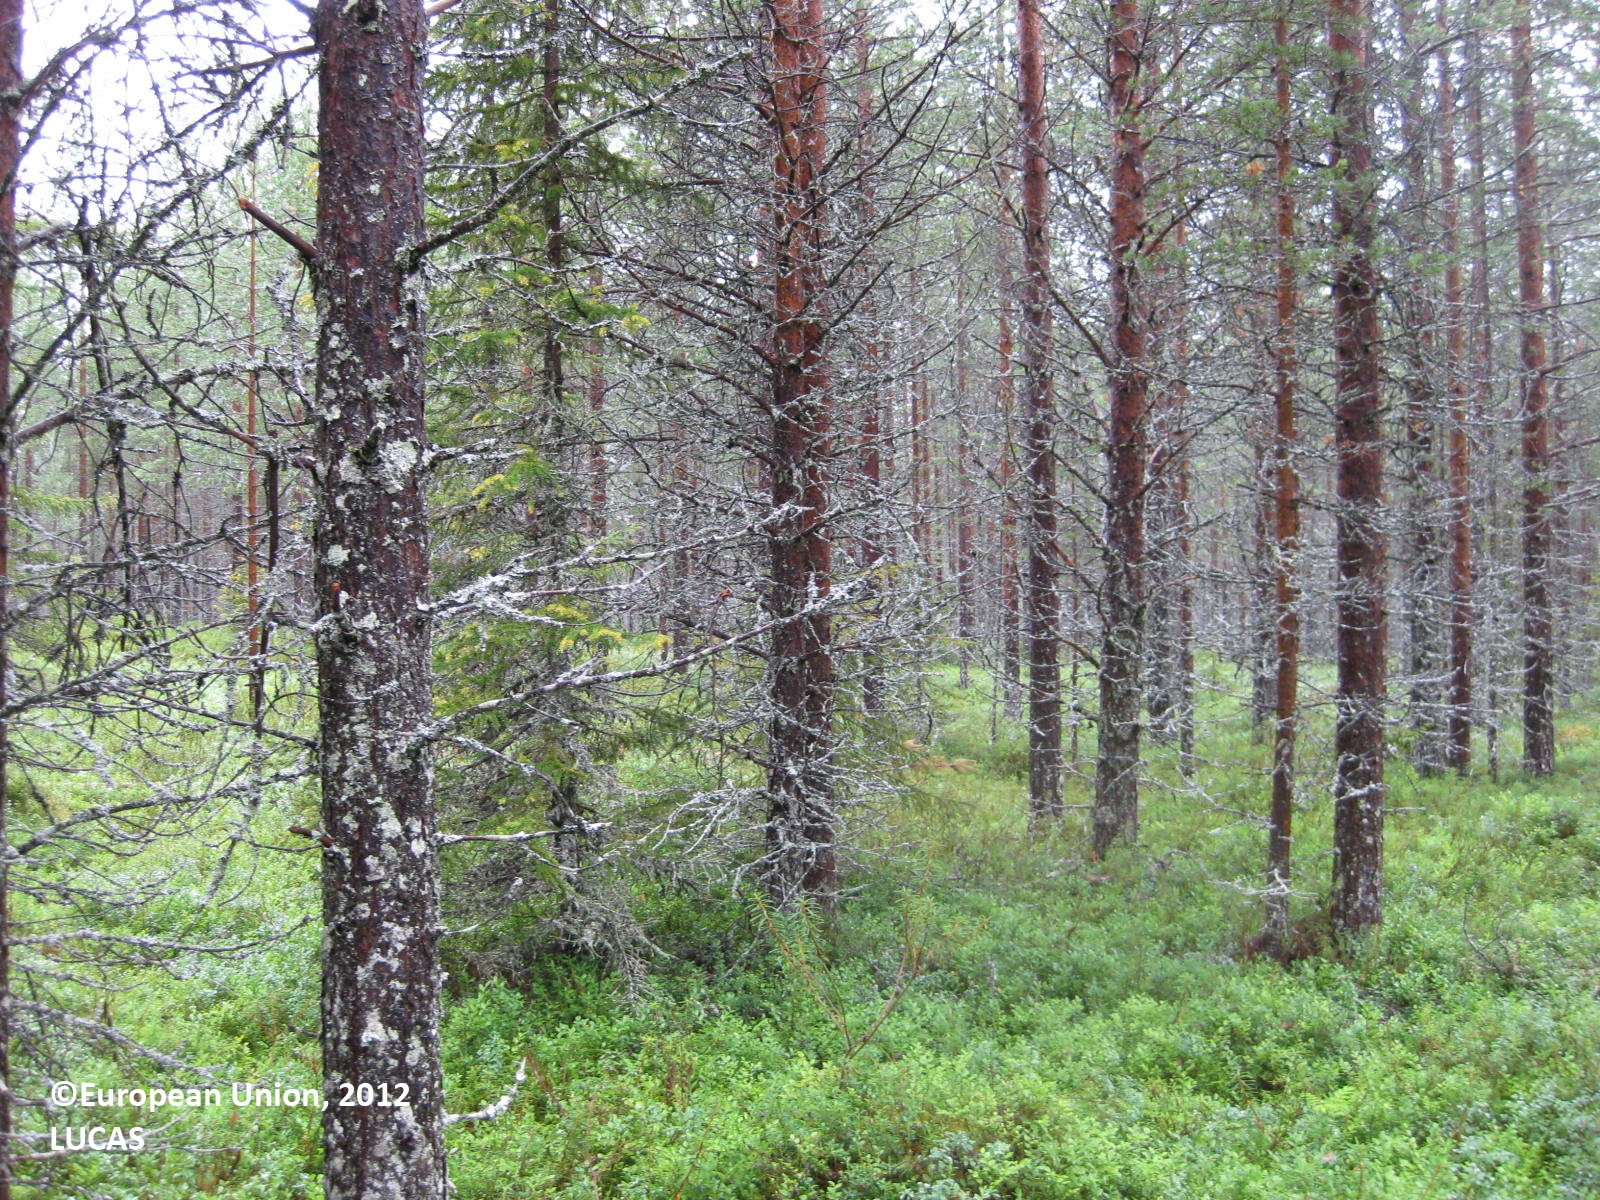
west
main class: Woodland
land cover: Pine dominated coniferous woodland
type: boreal forest
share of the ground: 50 - 75 %
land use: Forestry
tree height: > 5 m
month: August
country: FI
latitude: 65.9885
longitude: 28.3172
